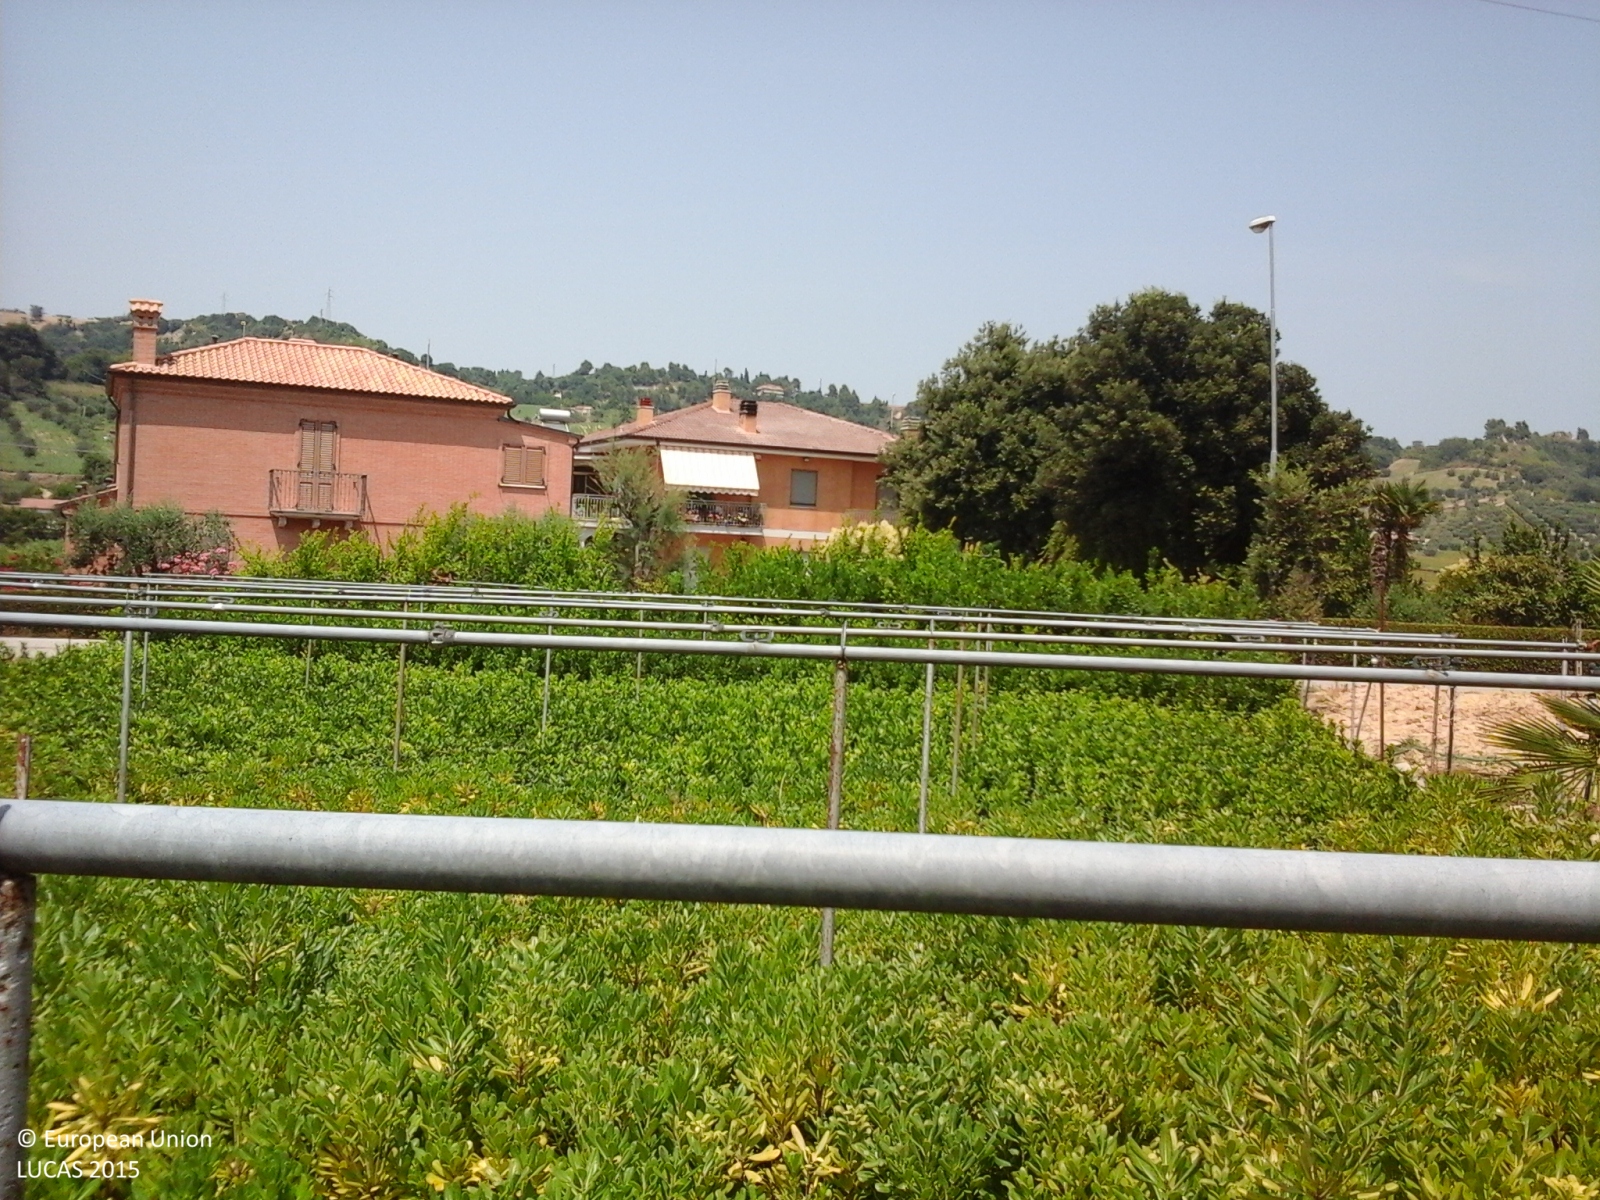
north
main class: Cropland
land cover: Nurseries
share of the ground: > 75 %
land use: Agriculture (excluding fallow land and kitchen gardens)
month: July
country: IT
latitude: 43.0344
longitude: 13.8070
